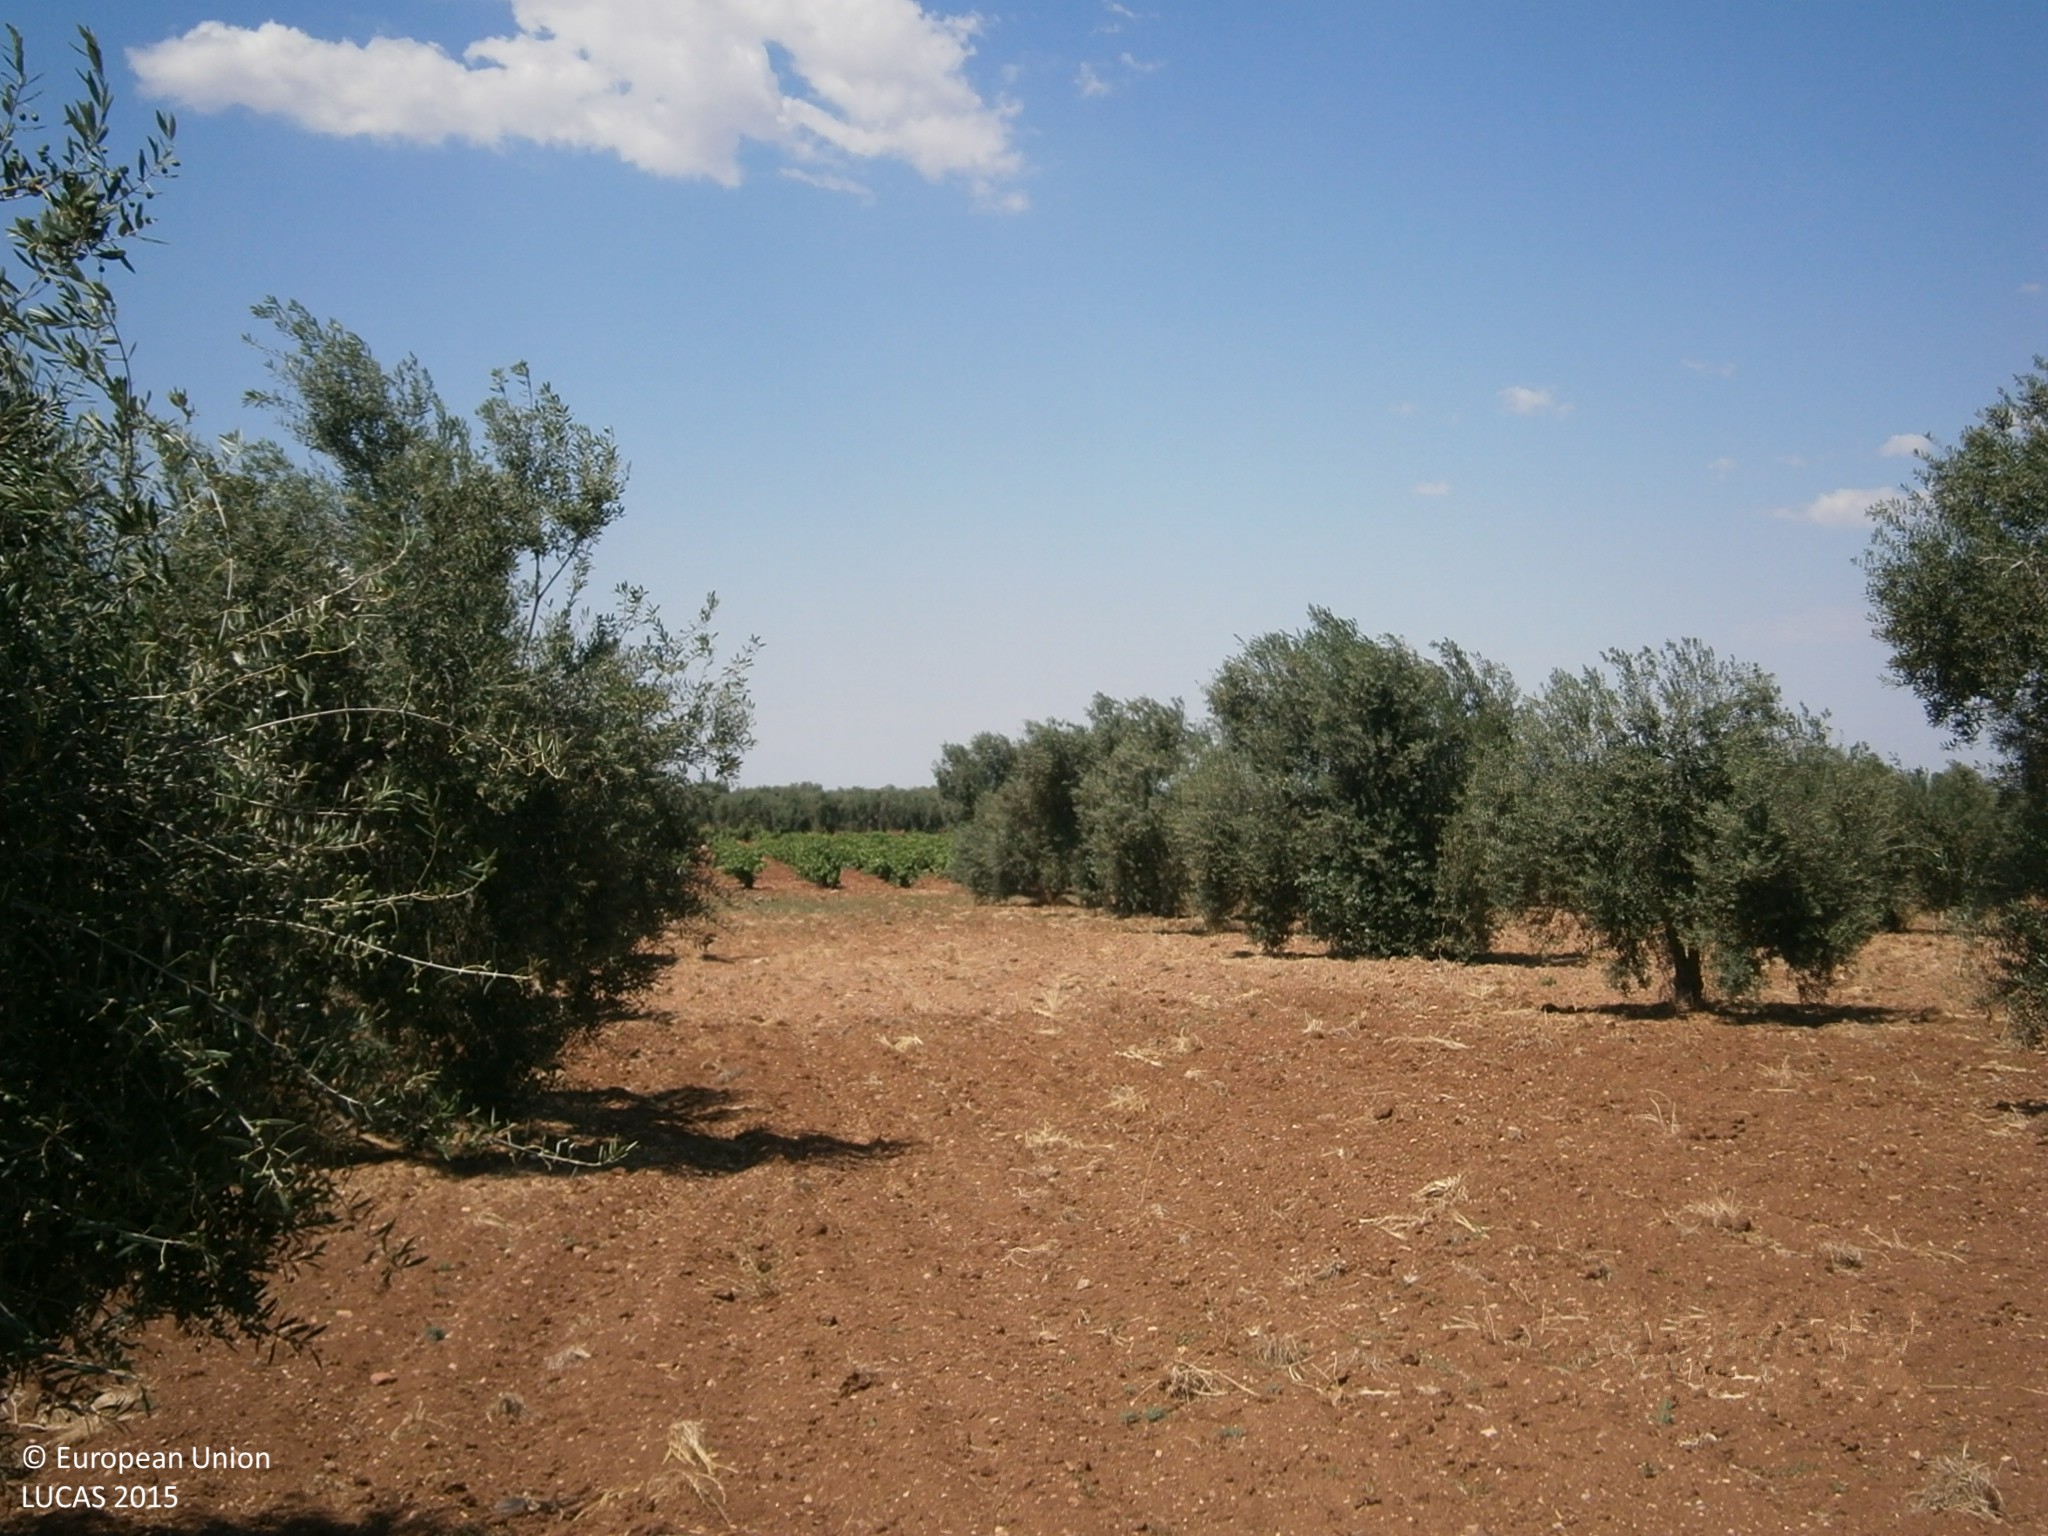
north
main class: Cropland
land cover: Olive groves
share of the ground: 25 - 50 %
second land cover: Other bare soil
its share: > 75 %
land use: Agriculture (excluding fallow land and kitchen gardens)
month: June
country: ES
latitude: 38.5977
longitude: -6.4152
